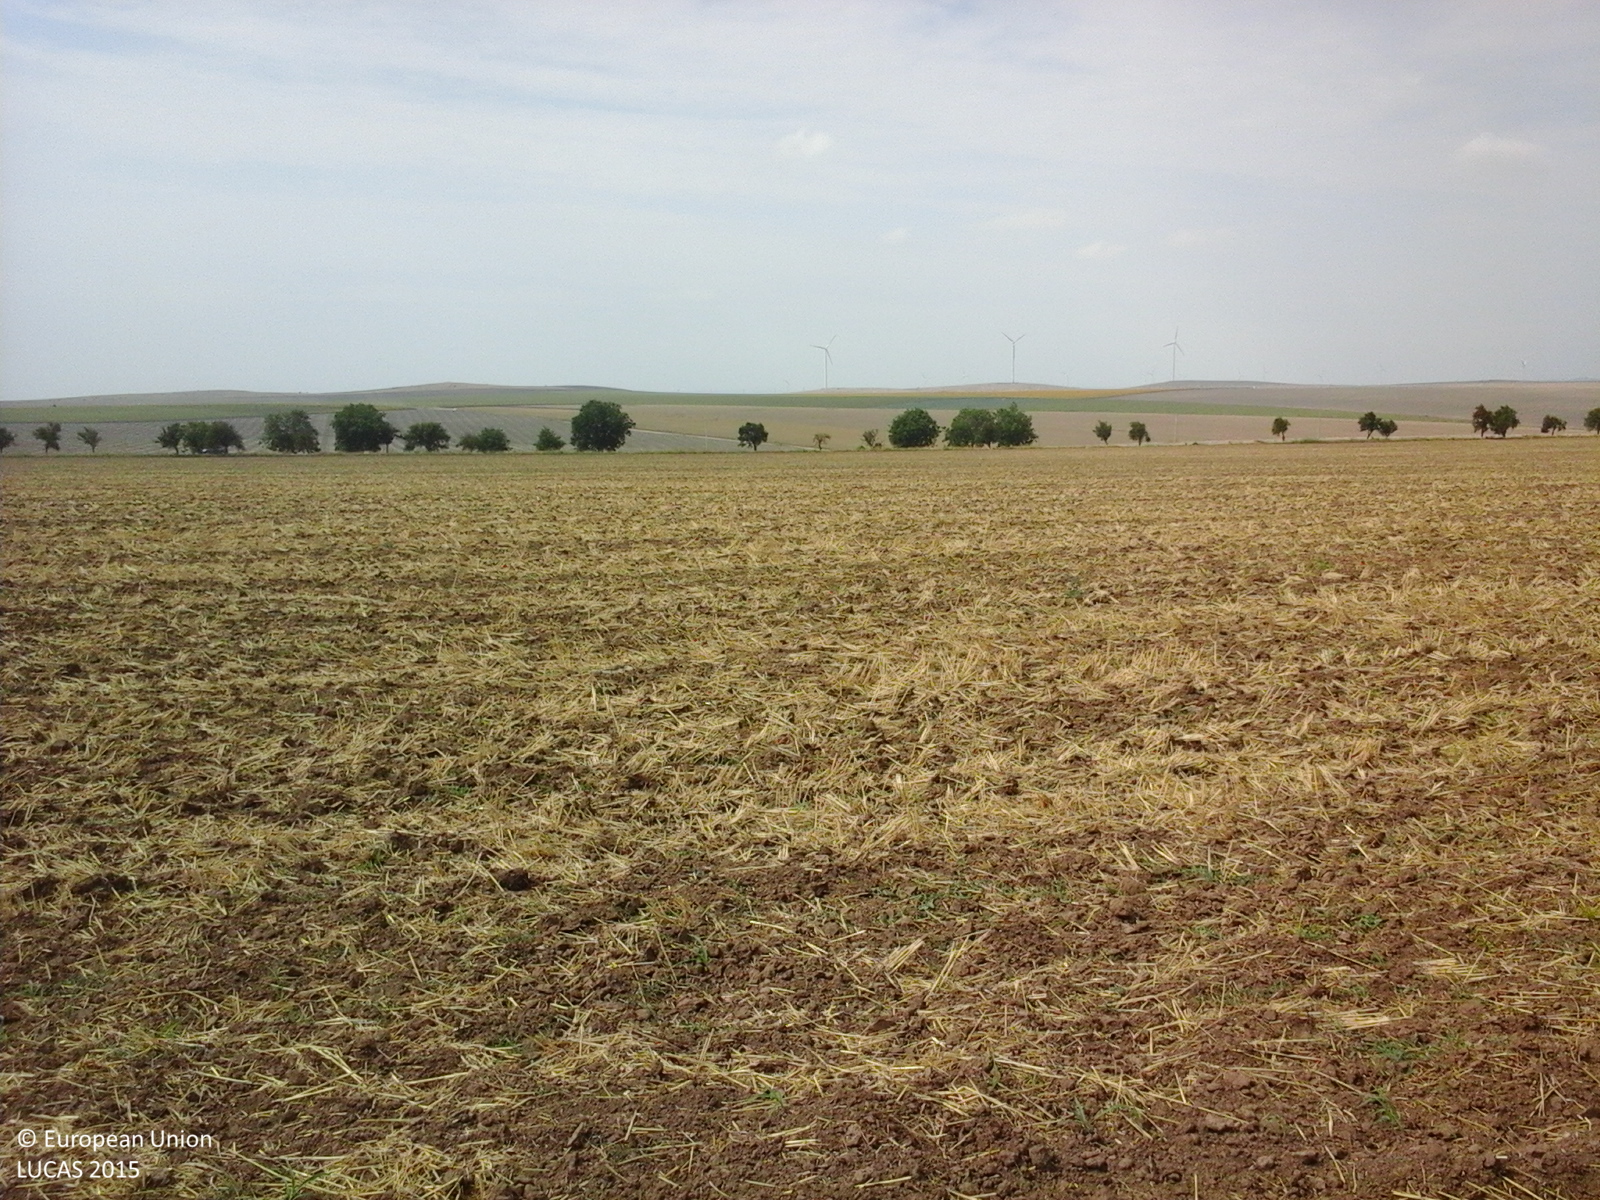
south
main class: Cropland
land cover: Common wheat
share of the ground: 25 - 50 %
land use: Agriculture (excluding fallow land and kitchen gardens)
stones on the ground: < 10 %
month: August
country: RO
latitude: 45.0825
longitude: 29.0392
